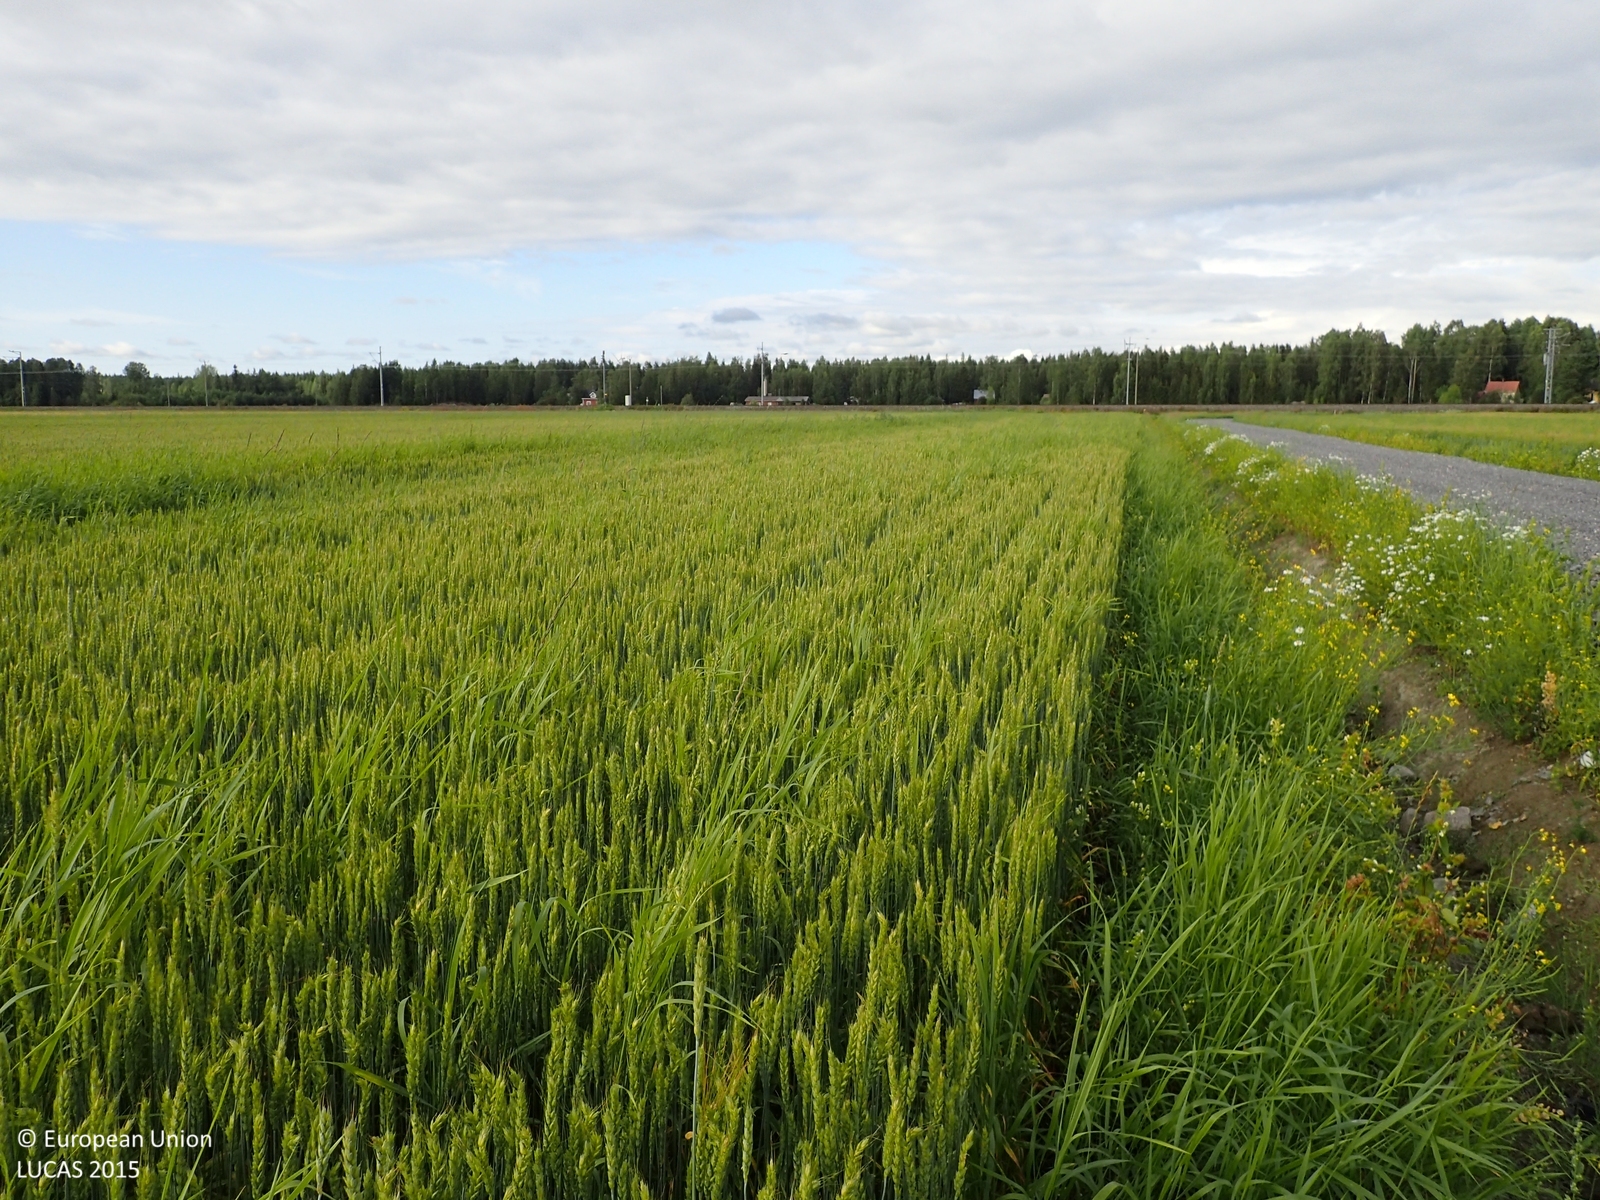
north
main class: Cropland
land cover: Common wheat
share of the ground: > 75 %
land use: Agriculture (excluding fallow land and kitchen gardens)
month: July
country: FI
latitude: 62.9909
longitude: 21.9863
